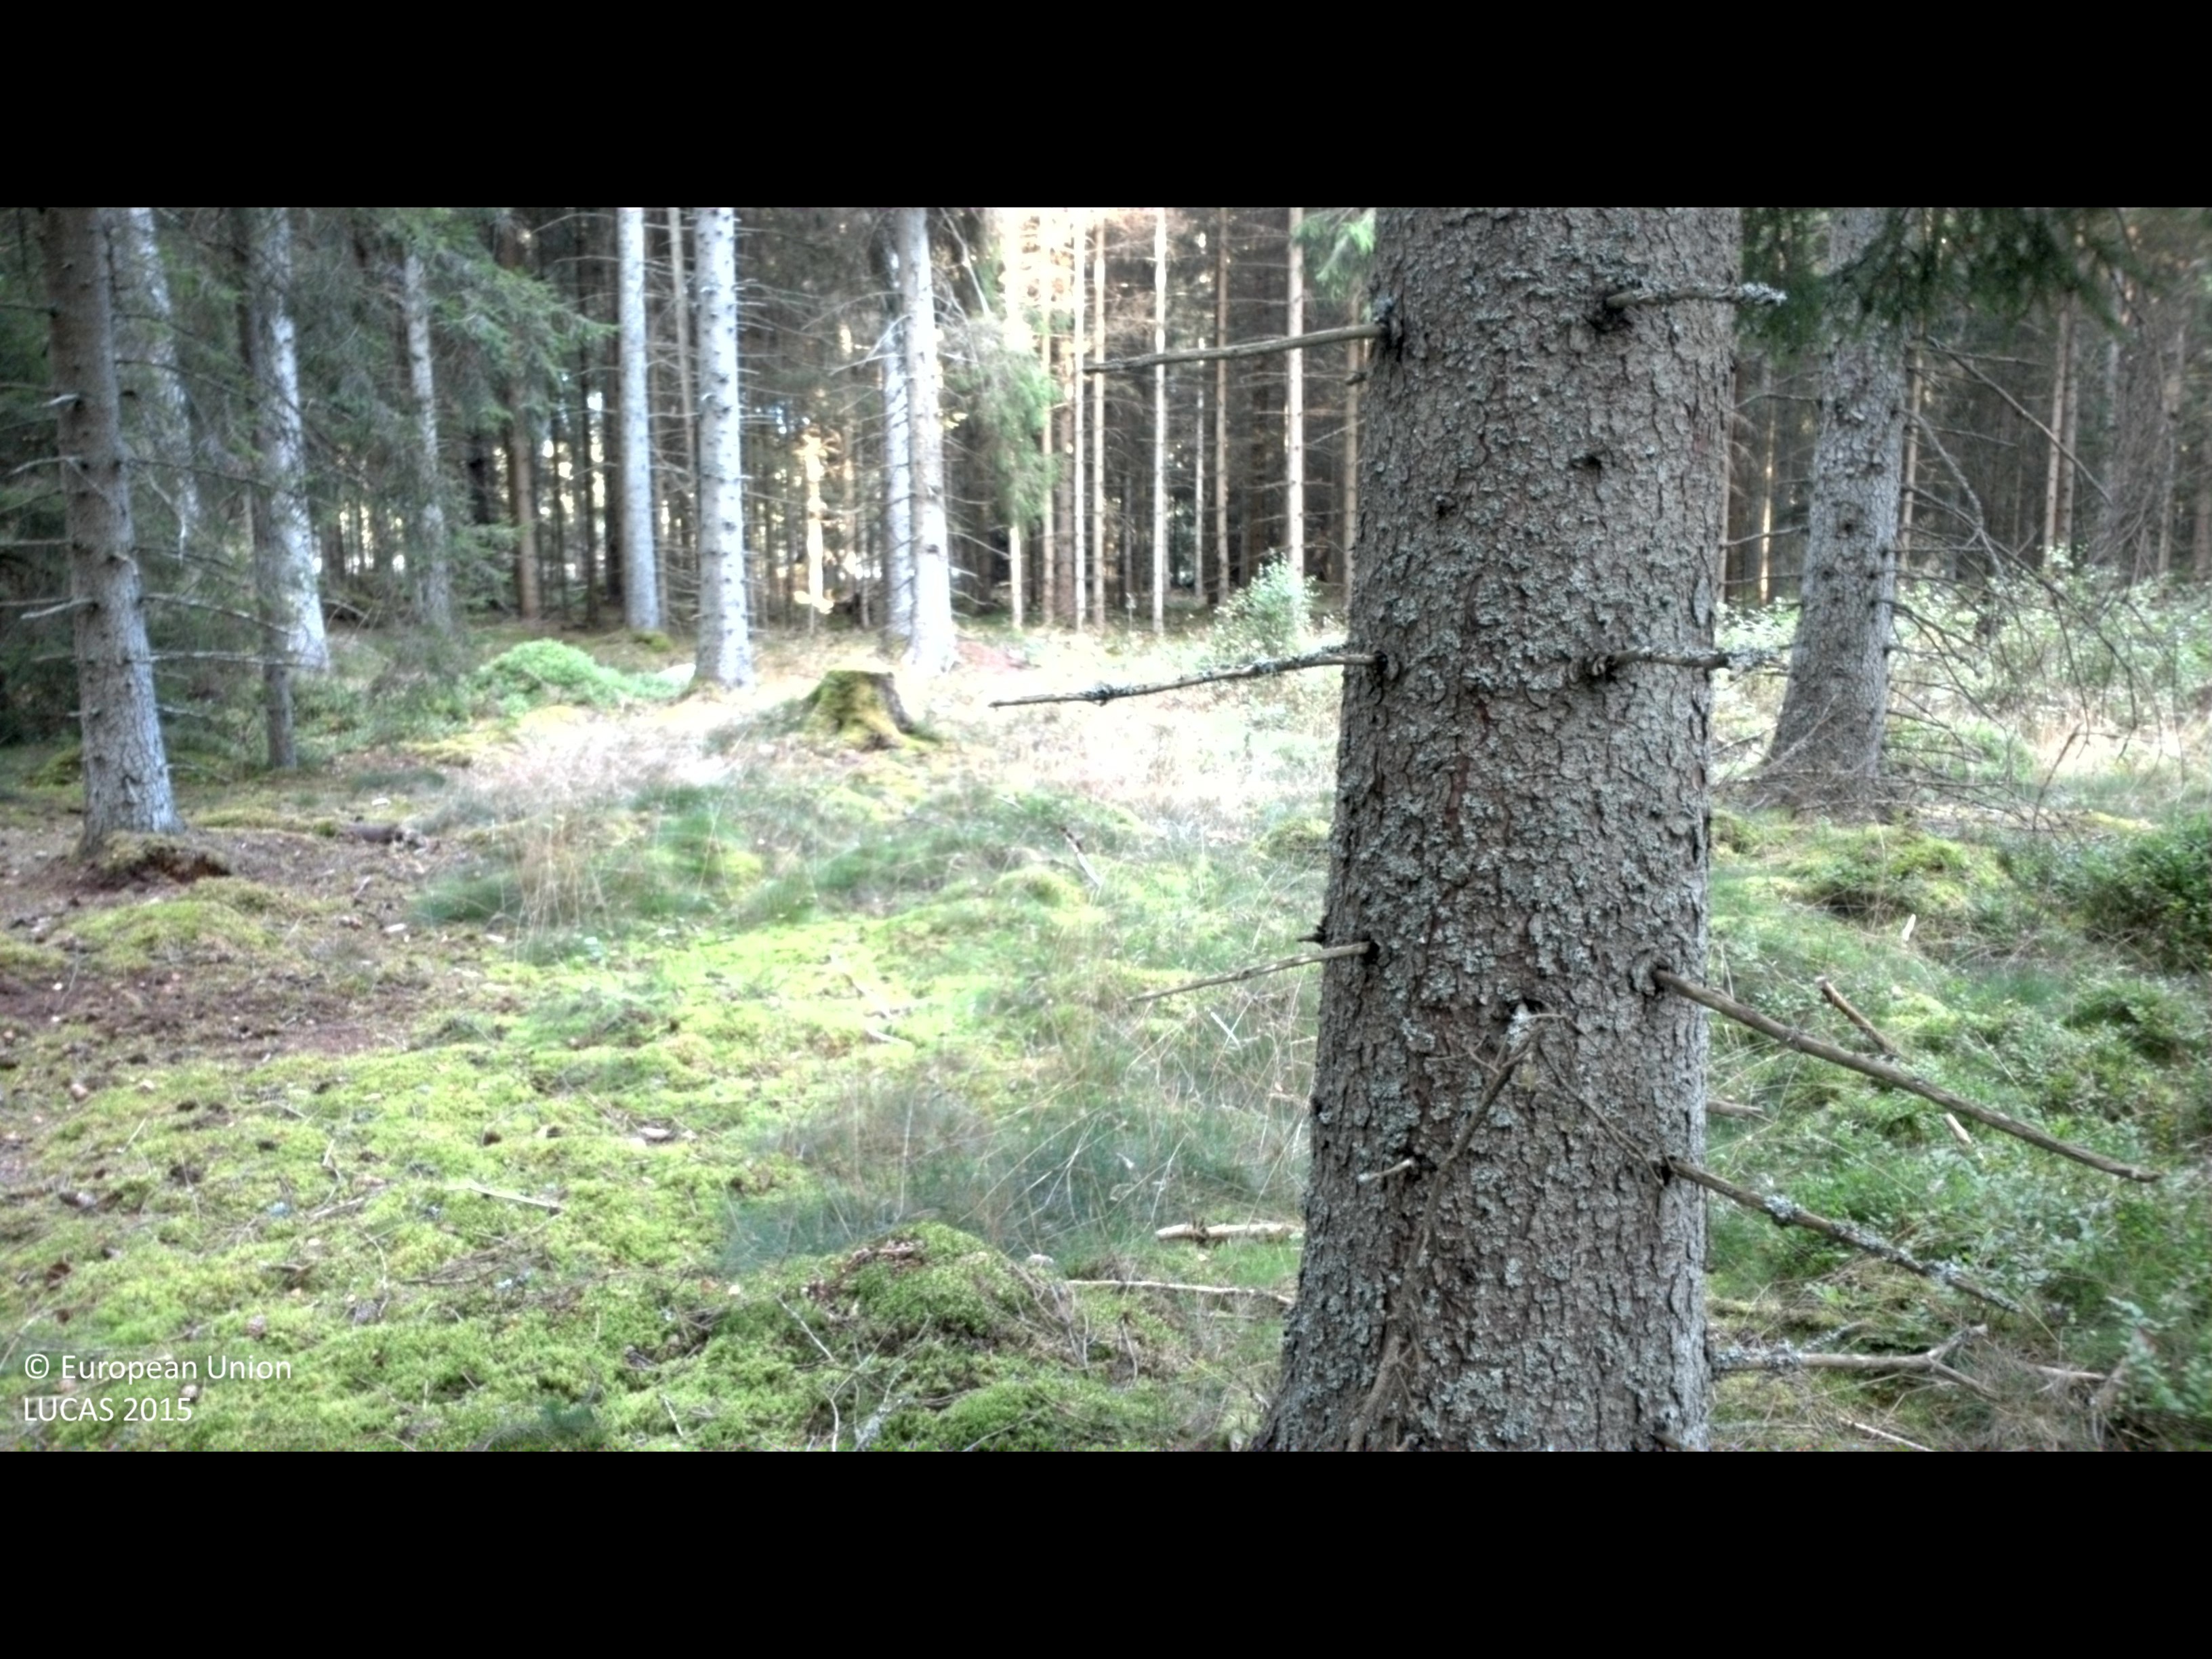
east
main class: Woodland
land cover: Spruce dominated coniferous woodland
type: boreal forest
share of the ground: 50 - 75 %
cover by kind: coniferous forest trees 65 %, lichens and mosses 20 %, shrubs 15 %
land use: Forestry
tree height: > 5 m
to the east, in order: Spruce dominated coniferous woodland; Grassland with sparse tree/shrub cover; Abandoned hedges; Grassland without tree/shrub cover; Abandoned hedges; Ditches and canals; Abandoned hedges; Fences; Grassland without tree/shrub cover; Groves; Ditches and canals; Groves; Tracks; Broadleaved woodland; Ditches and canals; Broadleaved woodland
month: August
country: SE
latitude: 56.2986
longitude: 14.2152
